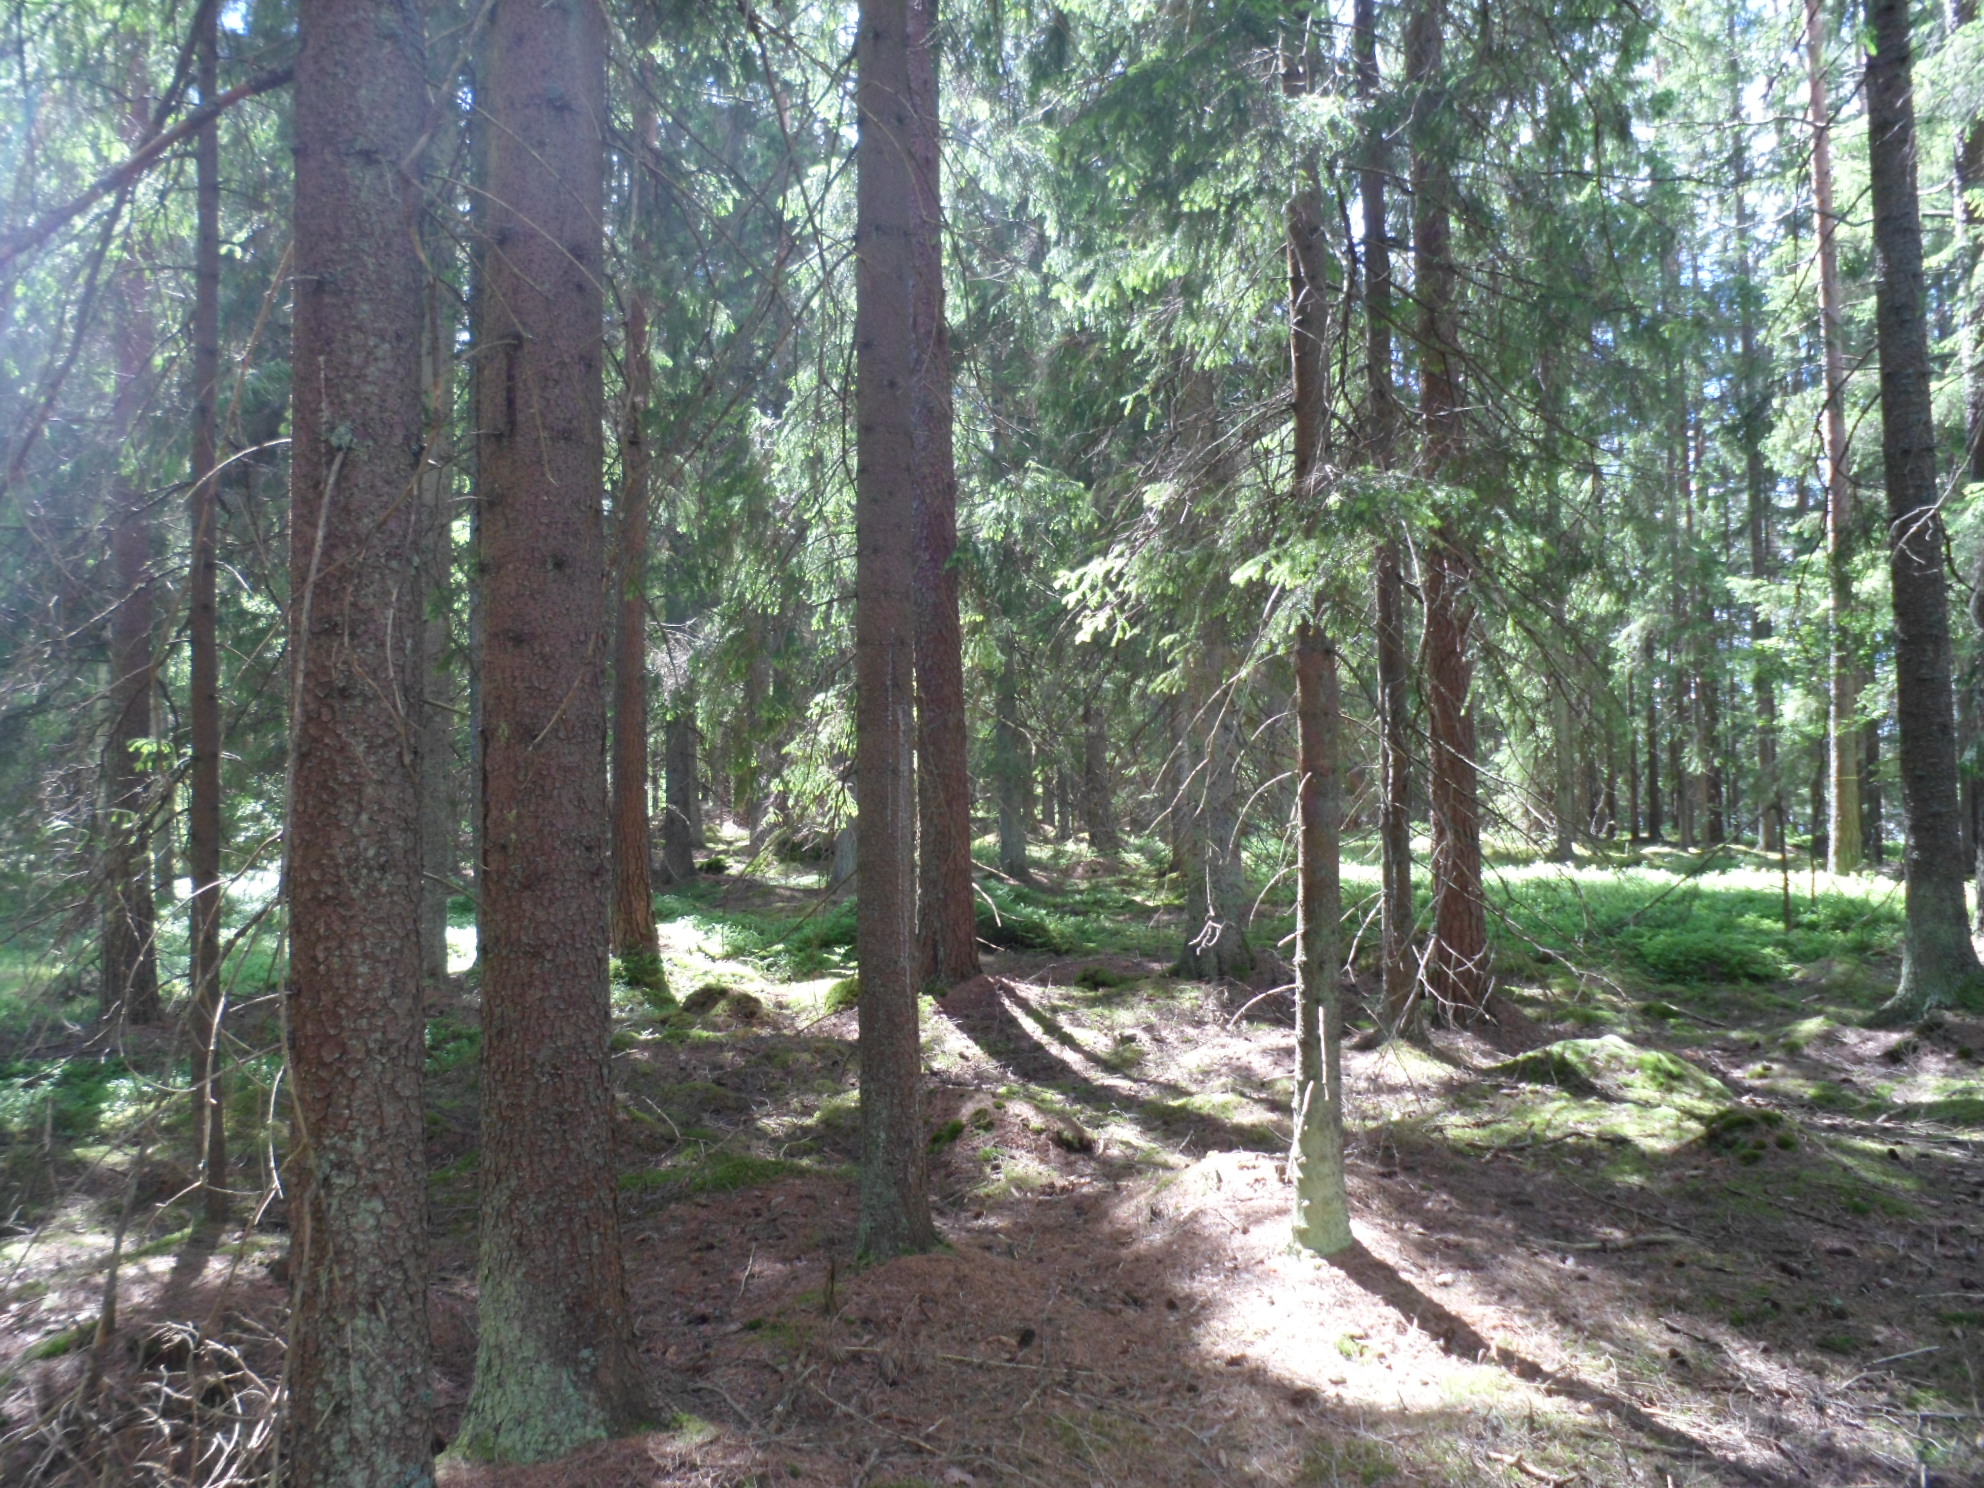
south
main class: Woodland
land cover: Pine dominated coniferous woodland
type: boreal forest
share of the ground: 25 - 50 %
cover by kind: coniferous forest trees 50 %, lichens and mosses 25 %, shrubs 15 %, consolidated bare surface 10 %
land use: Forestry
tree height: > 5 m
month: June
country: SE
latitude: 57.1809
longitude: 14.2146
